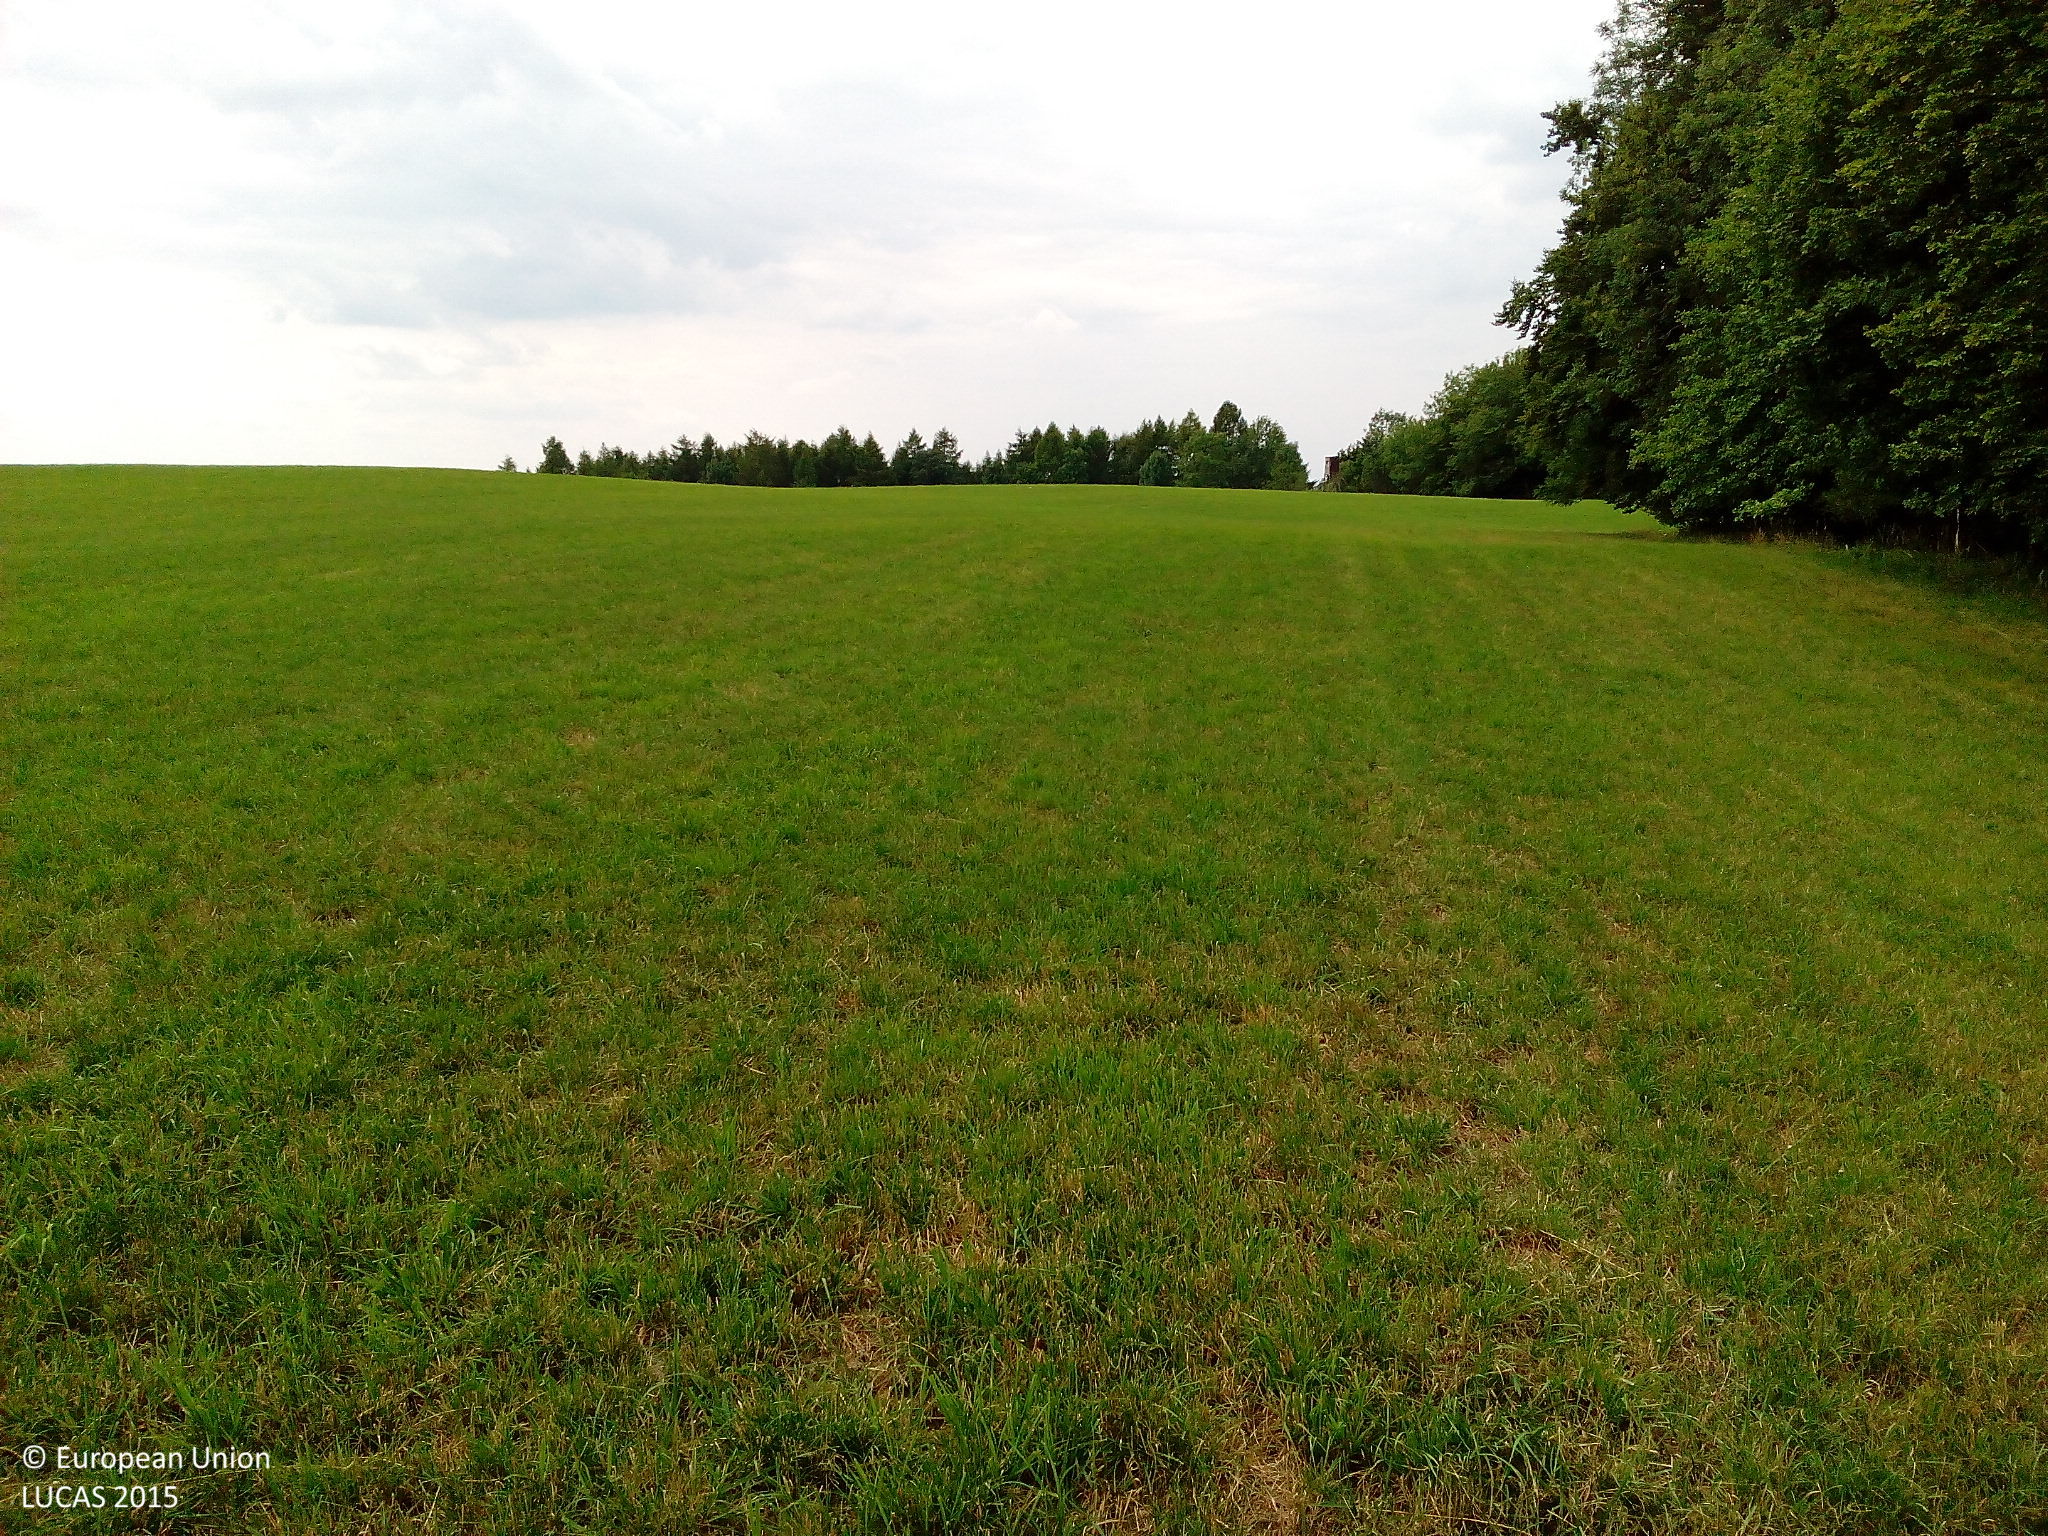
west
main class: Grassland
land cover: Grassland without tree/shrub cover
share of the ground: > 75 %
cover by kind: herbaceous plants 100 %
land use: Agriculture (excluding fallow land and kitchen gardens)
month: July
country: DE
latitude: 50.8135
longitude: 9.9007
